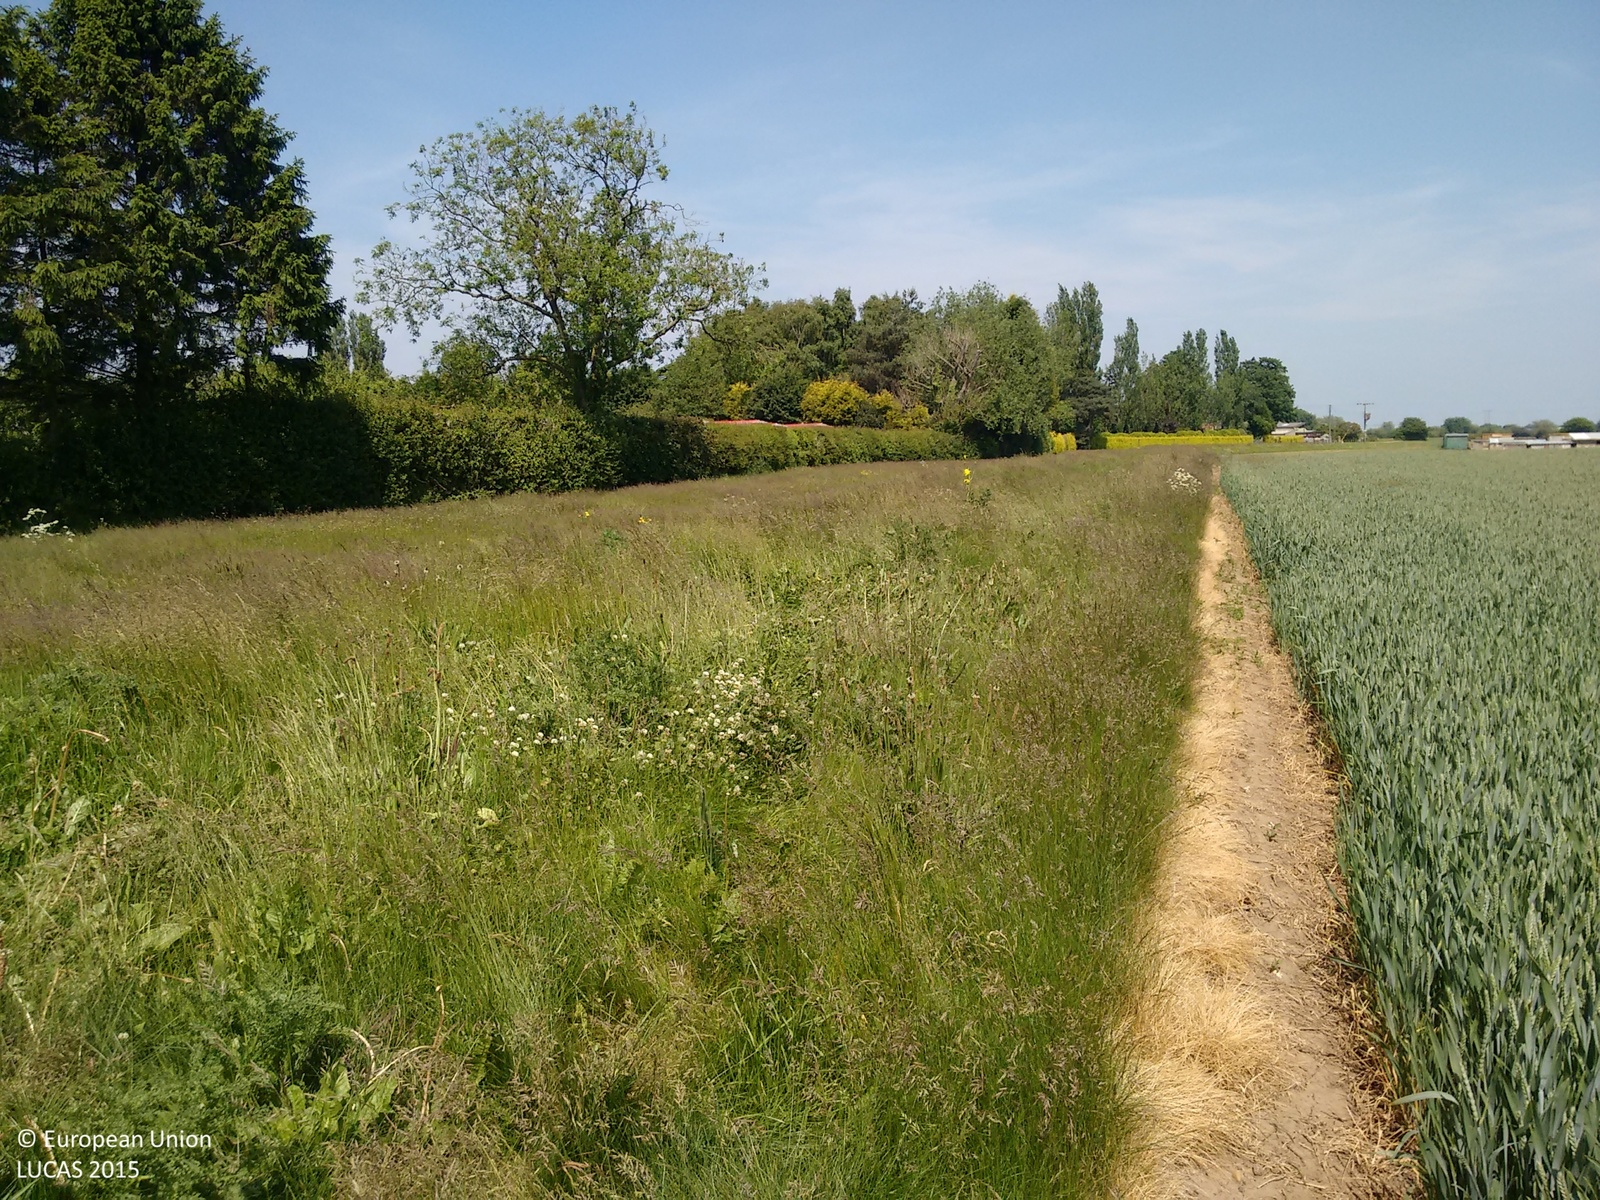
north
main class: Cropland
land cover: Common wheat
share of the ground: > 75 %
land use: Agriculture (excluding fallow land and kitchen gardens)
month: June
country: GB
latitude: 53.8320
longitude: -1.1213
